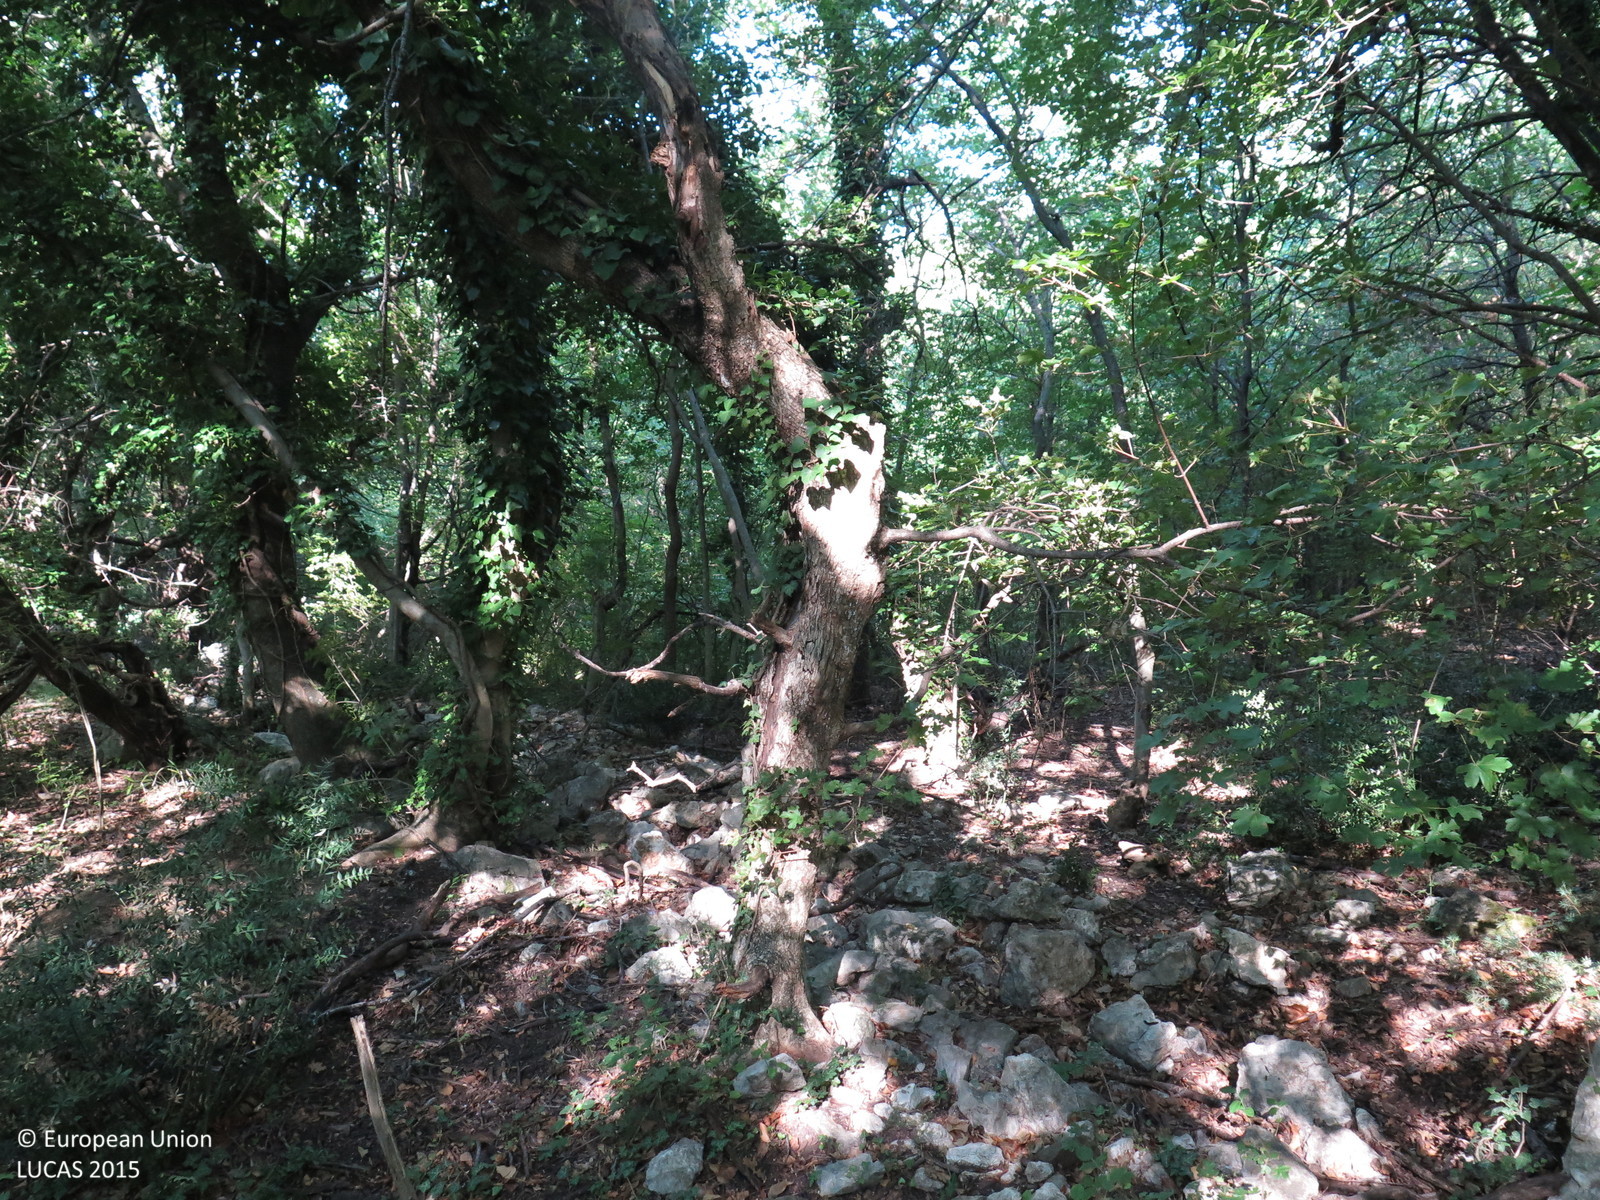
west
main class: Woodland
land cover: Broadleaved woodland
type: mesophytic deciduous forest
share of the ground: > 75 %
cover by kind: broadleaved forest trees 90 %, shrubs 5 %, herbaceous plants 5 %
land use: Semi-natural and natural areas not in use
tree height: > 5 m
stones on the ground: 25 - 50 %
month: August
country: HR
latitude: 45.2004
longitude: 14.7177
